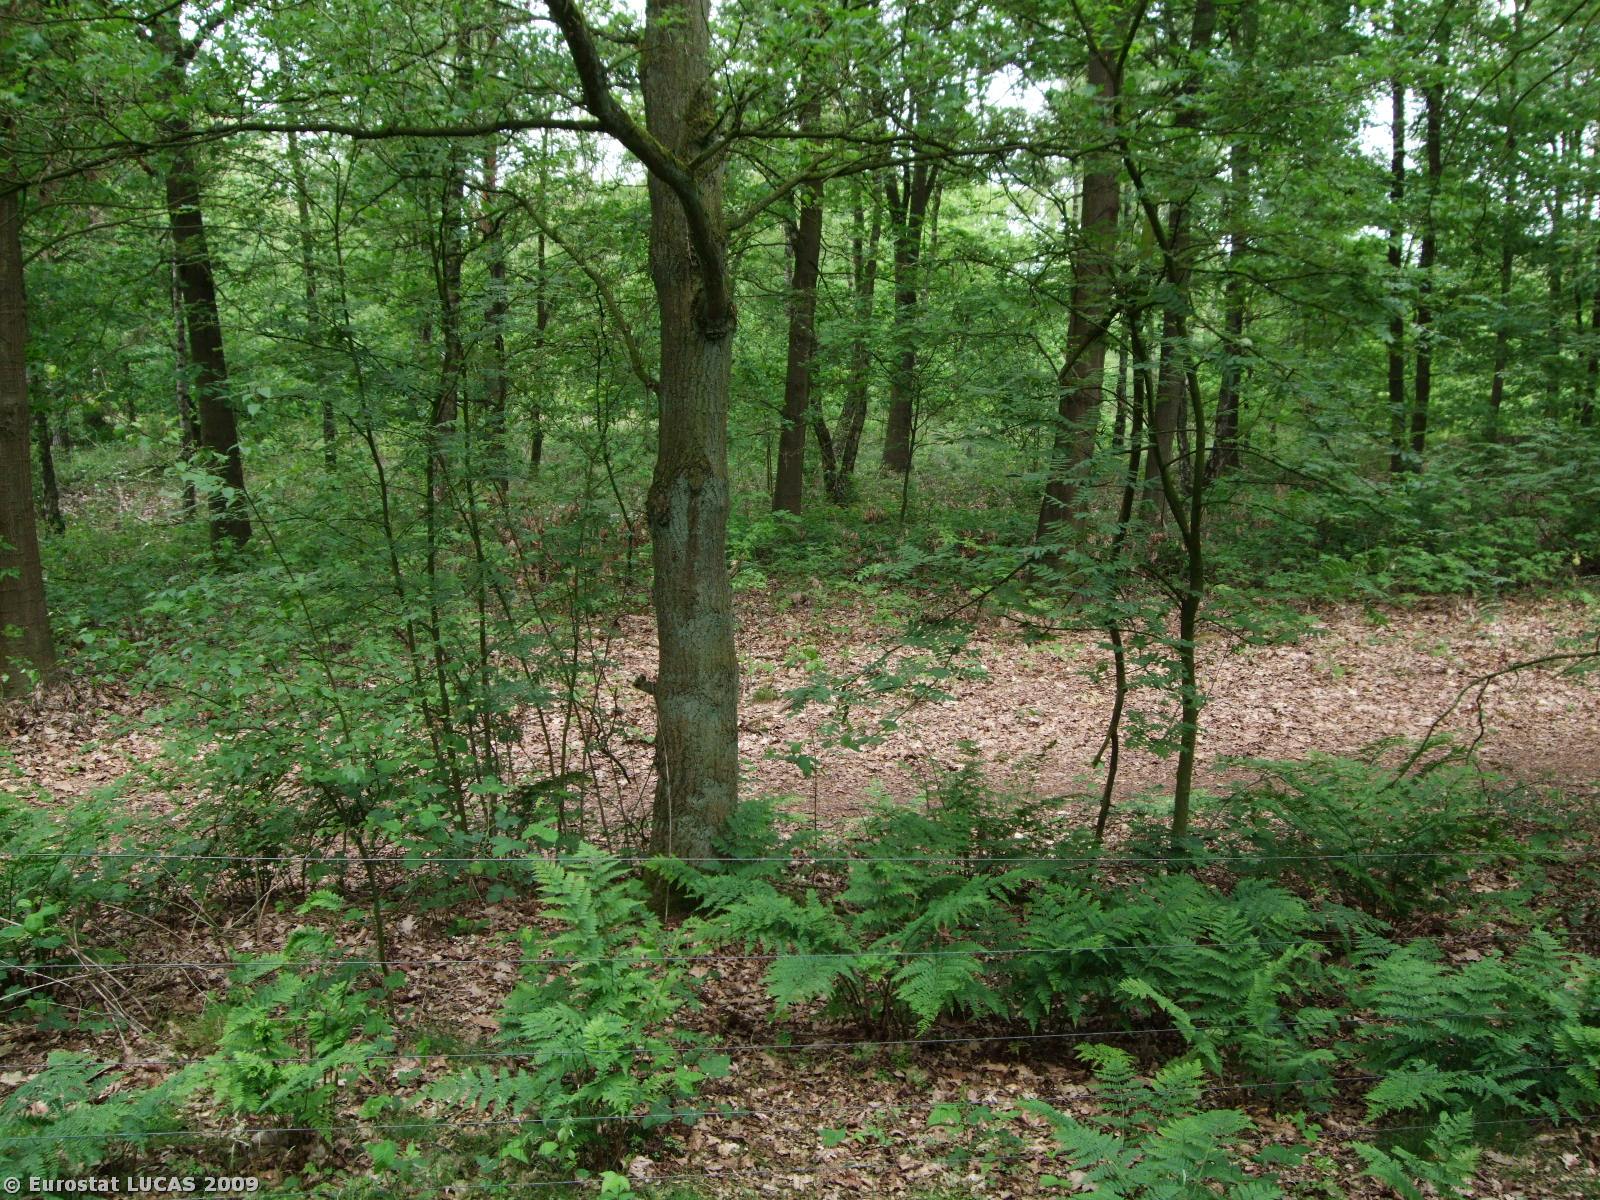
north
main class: Woodland
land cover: Mixed woodland
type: mesophytic deciduous forest
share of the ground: > 75 %
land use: Nature reserves
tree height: > 5 m
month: May
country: NL
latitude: 51.5063
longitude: 6.1812
